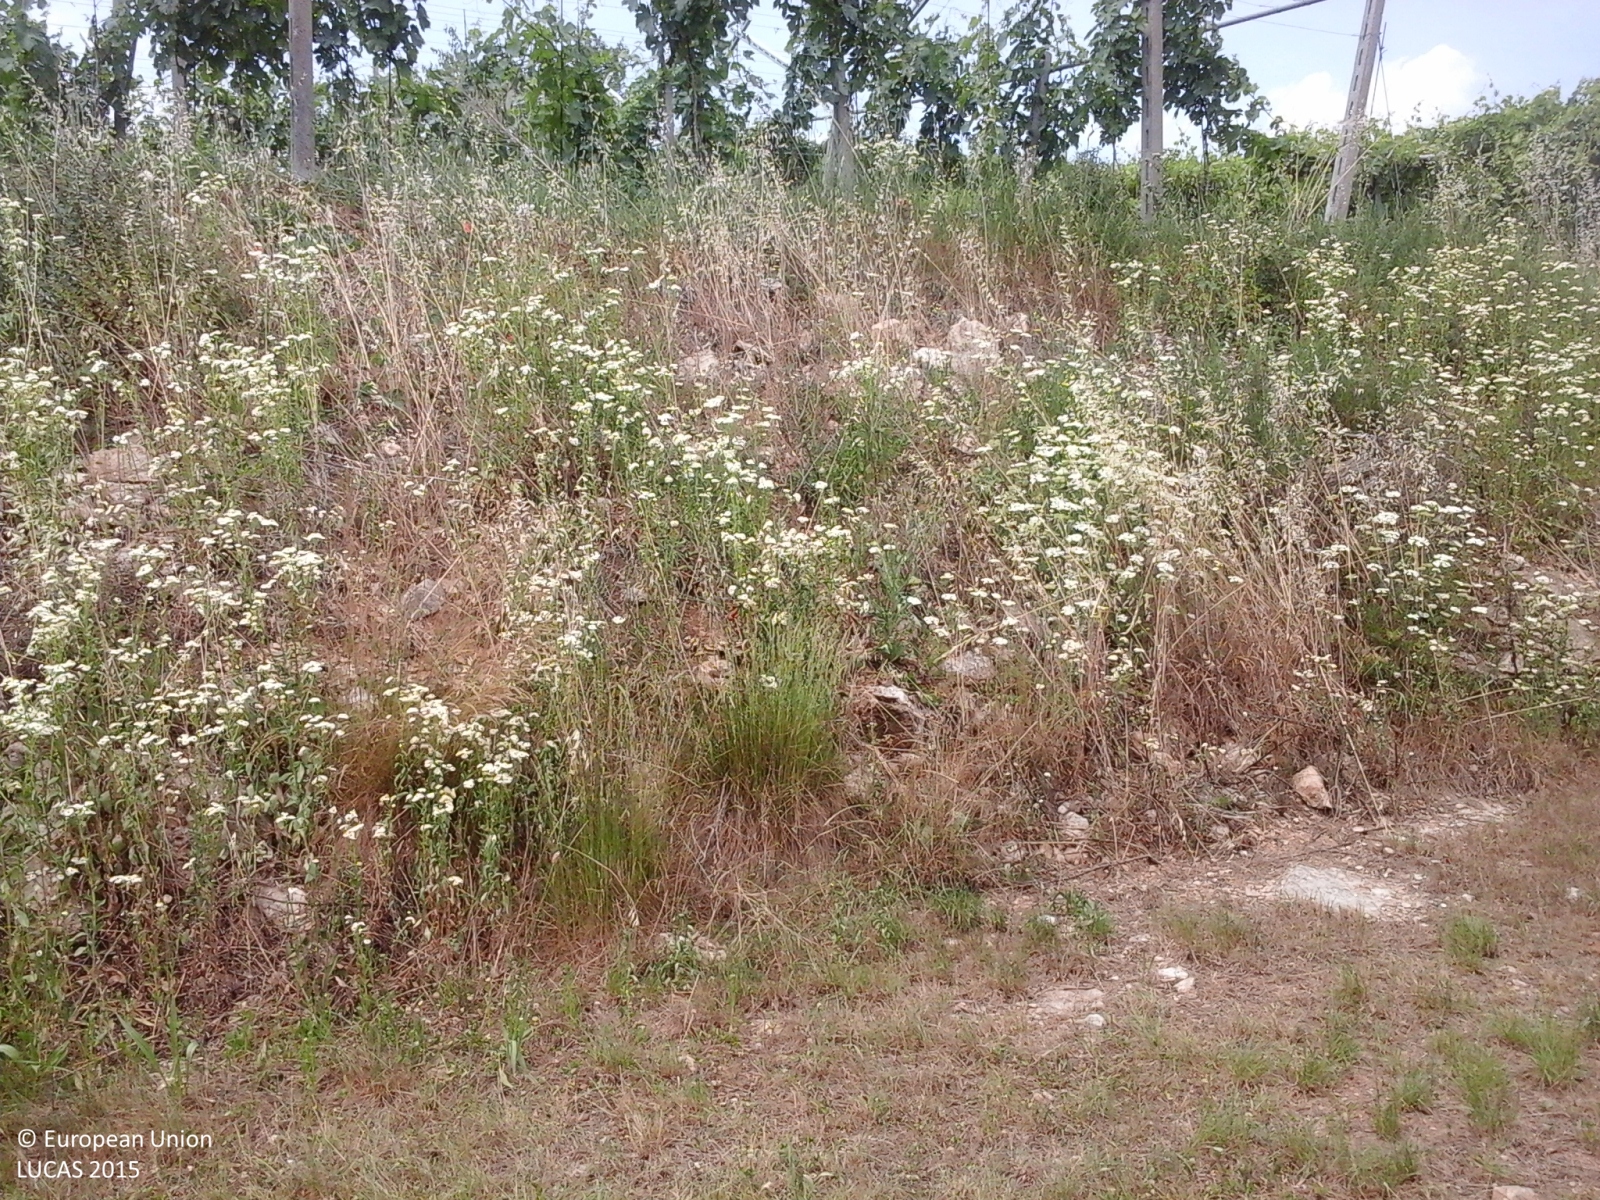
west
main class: Cropland
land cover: Vineyards
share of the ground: > 75 %
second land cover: Grassland without tree/shrub cover
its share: > 75 %
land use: Agriculture (excluding fallow land and kitchen gardens)
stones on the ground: < 10 %
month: June
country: IT
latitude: 45.5546
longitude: 10.9080
